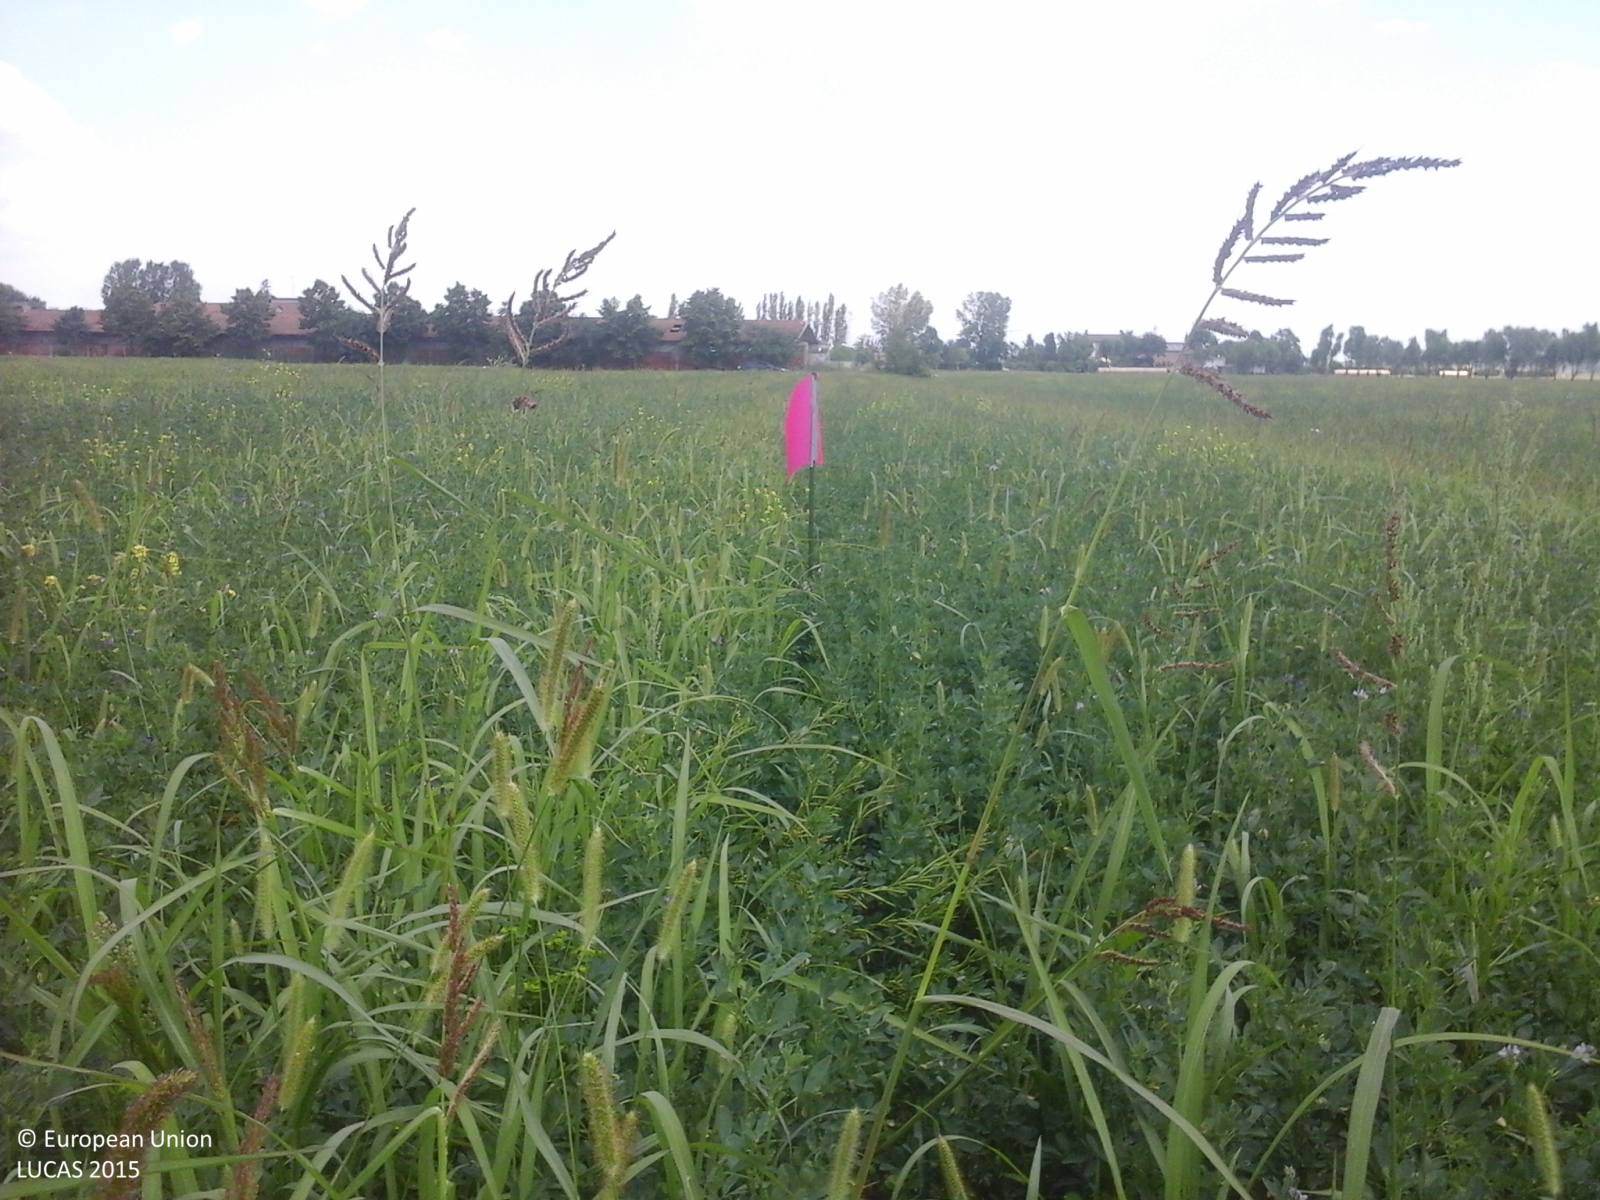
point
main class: Cropland
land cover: Lucerne
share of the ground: > 75 %
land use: Agriculture (excluding fallow land and kitchen gardens)
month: June
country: IT
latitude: 44.8154
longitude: 10.9212
